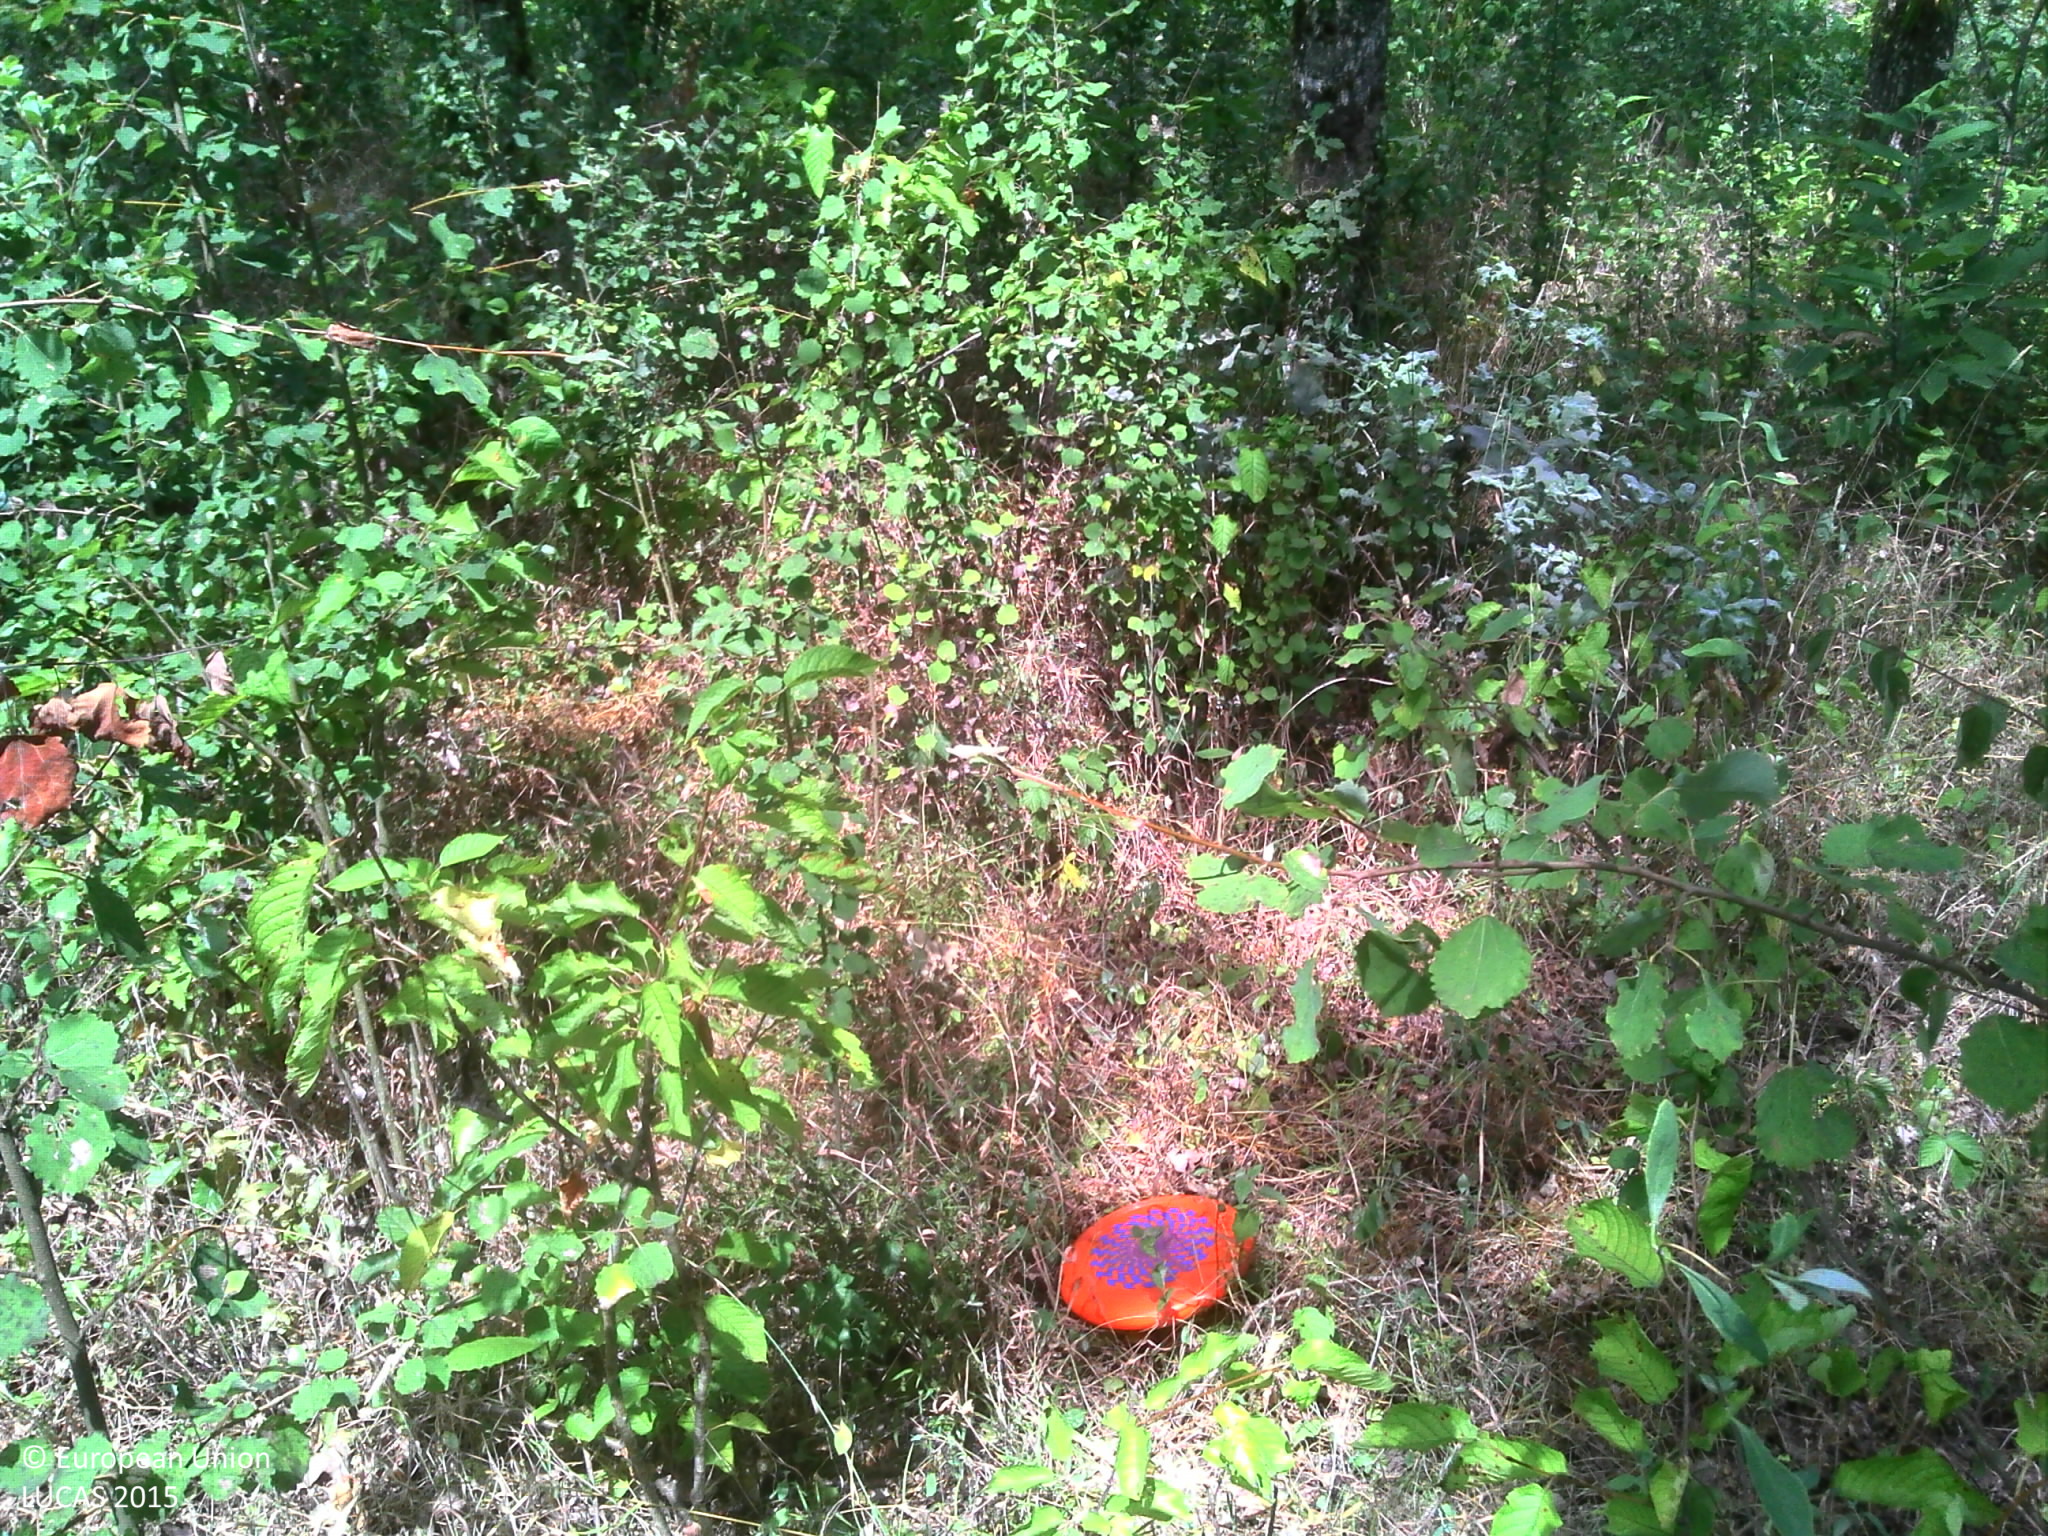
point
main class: Woodland
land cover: Broadleaved woodland
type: acidophilous oak and oak-birch forest
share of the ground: > 75 %
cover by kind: broadleaved forest trees 70 %, herbaceous plants 30 %
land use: Forestry
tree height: > 5 m
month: July
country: FR
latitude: 46.8391
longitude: 4.4541
